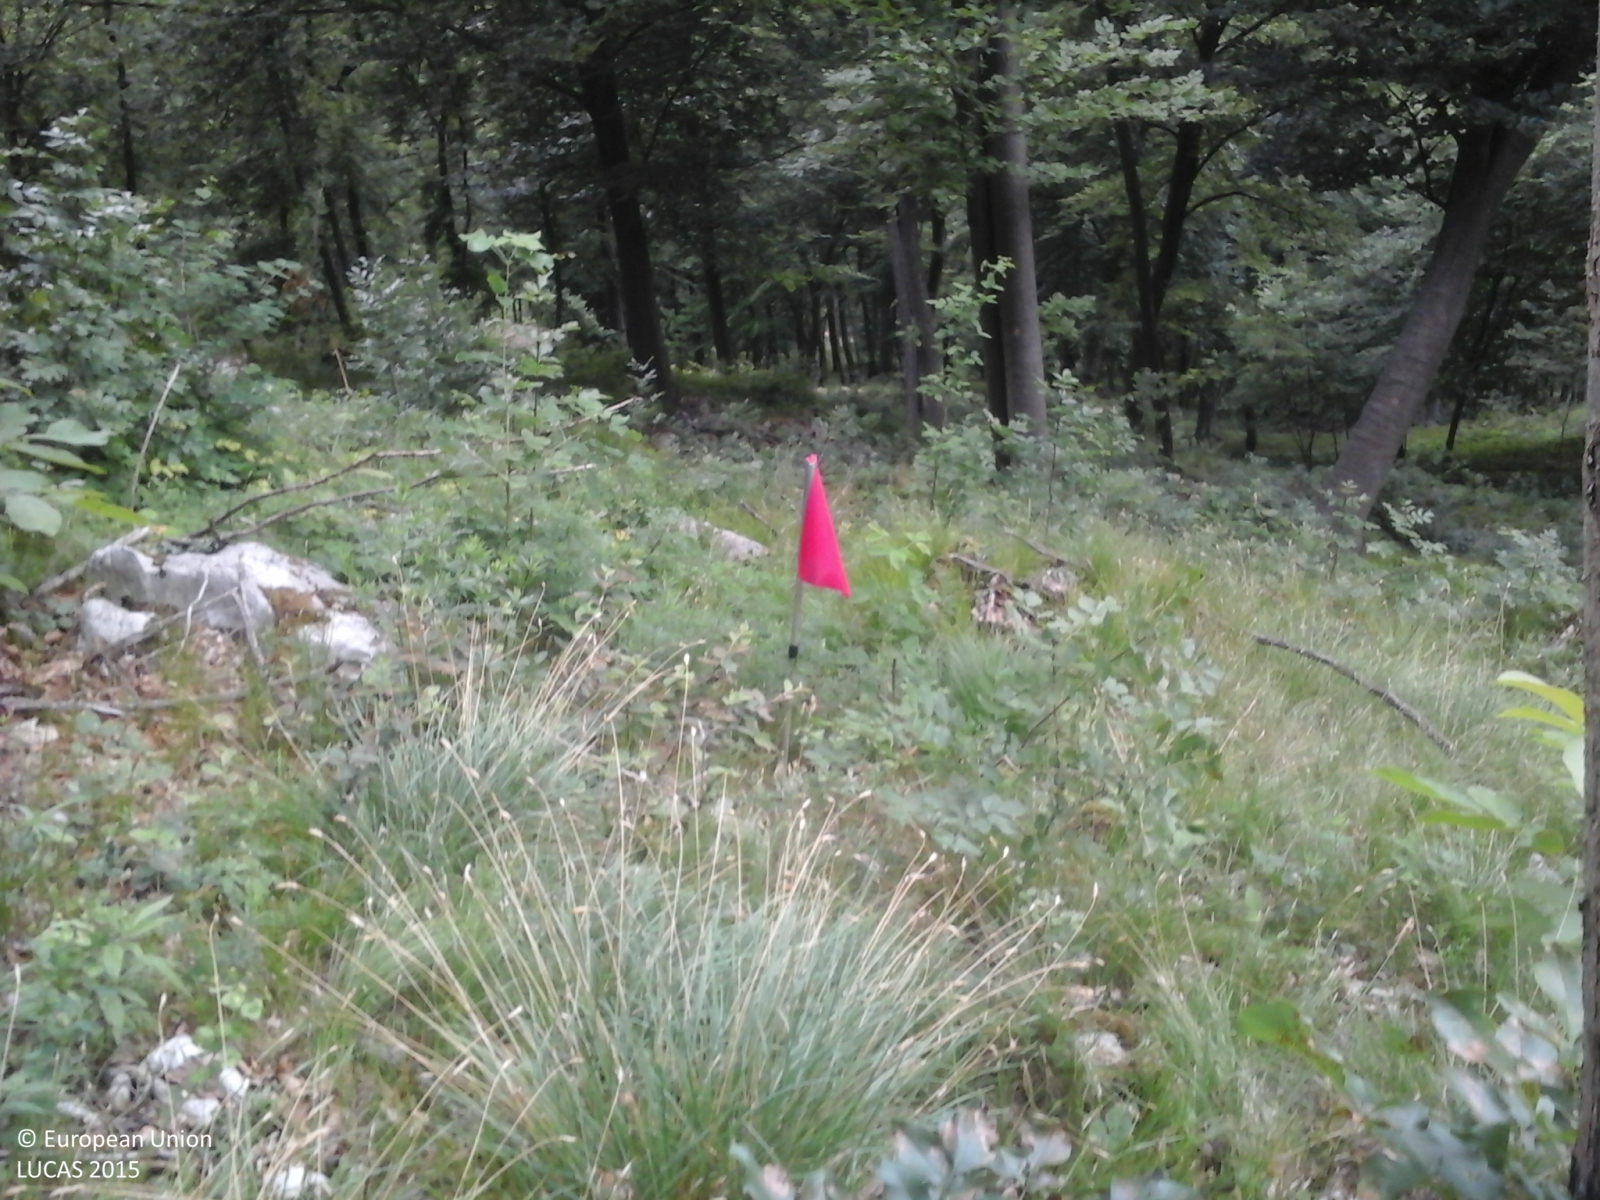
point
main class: Woodland
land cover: Broadleaved woodland
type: mountainous beech forest
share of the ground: > 75 %
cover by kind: broadleaved forest trees 90 %, herbaceous plants 10 %
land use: Forestry
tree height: > 5 m
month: May
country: IT
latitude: 45.6985
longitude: 10.9360
